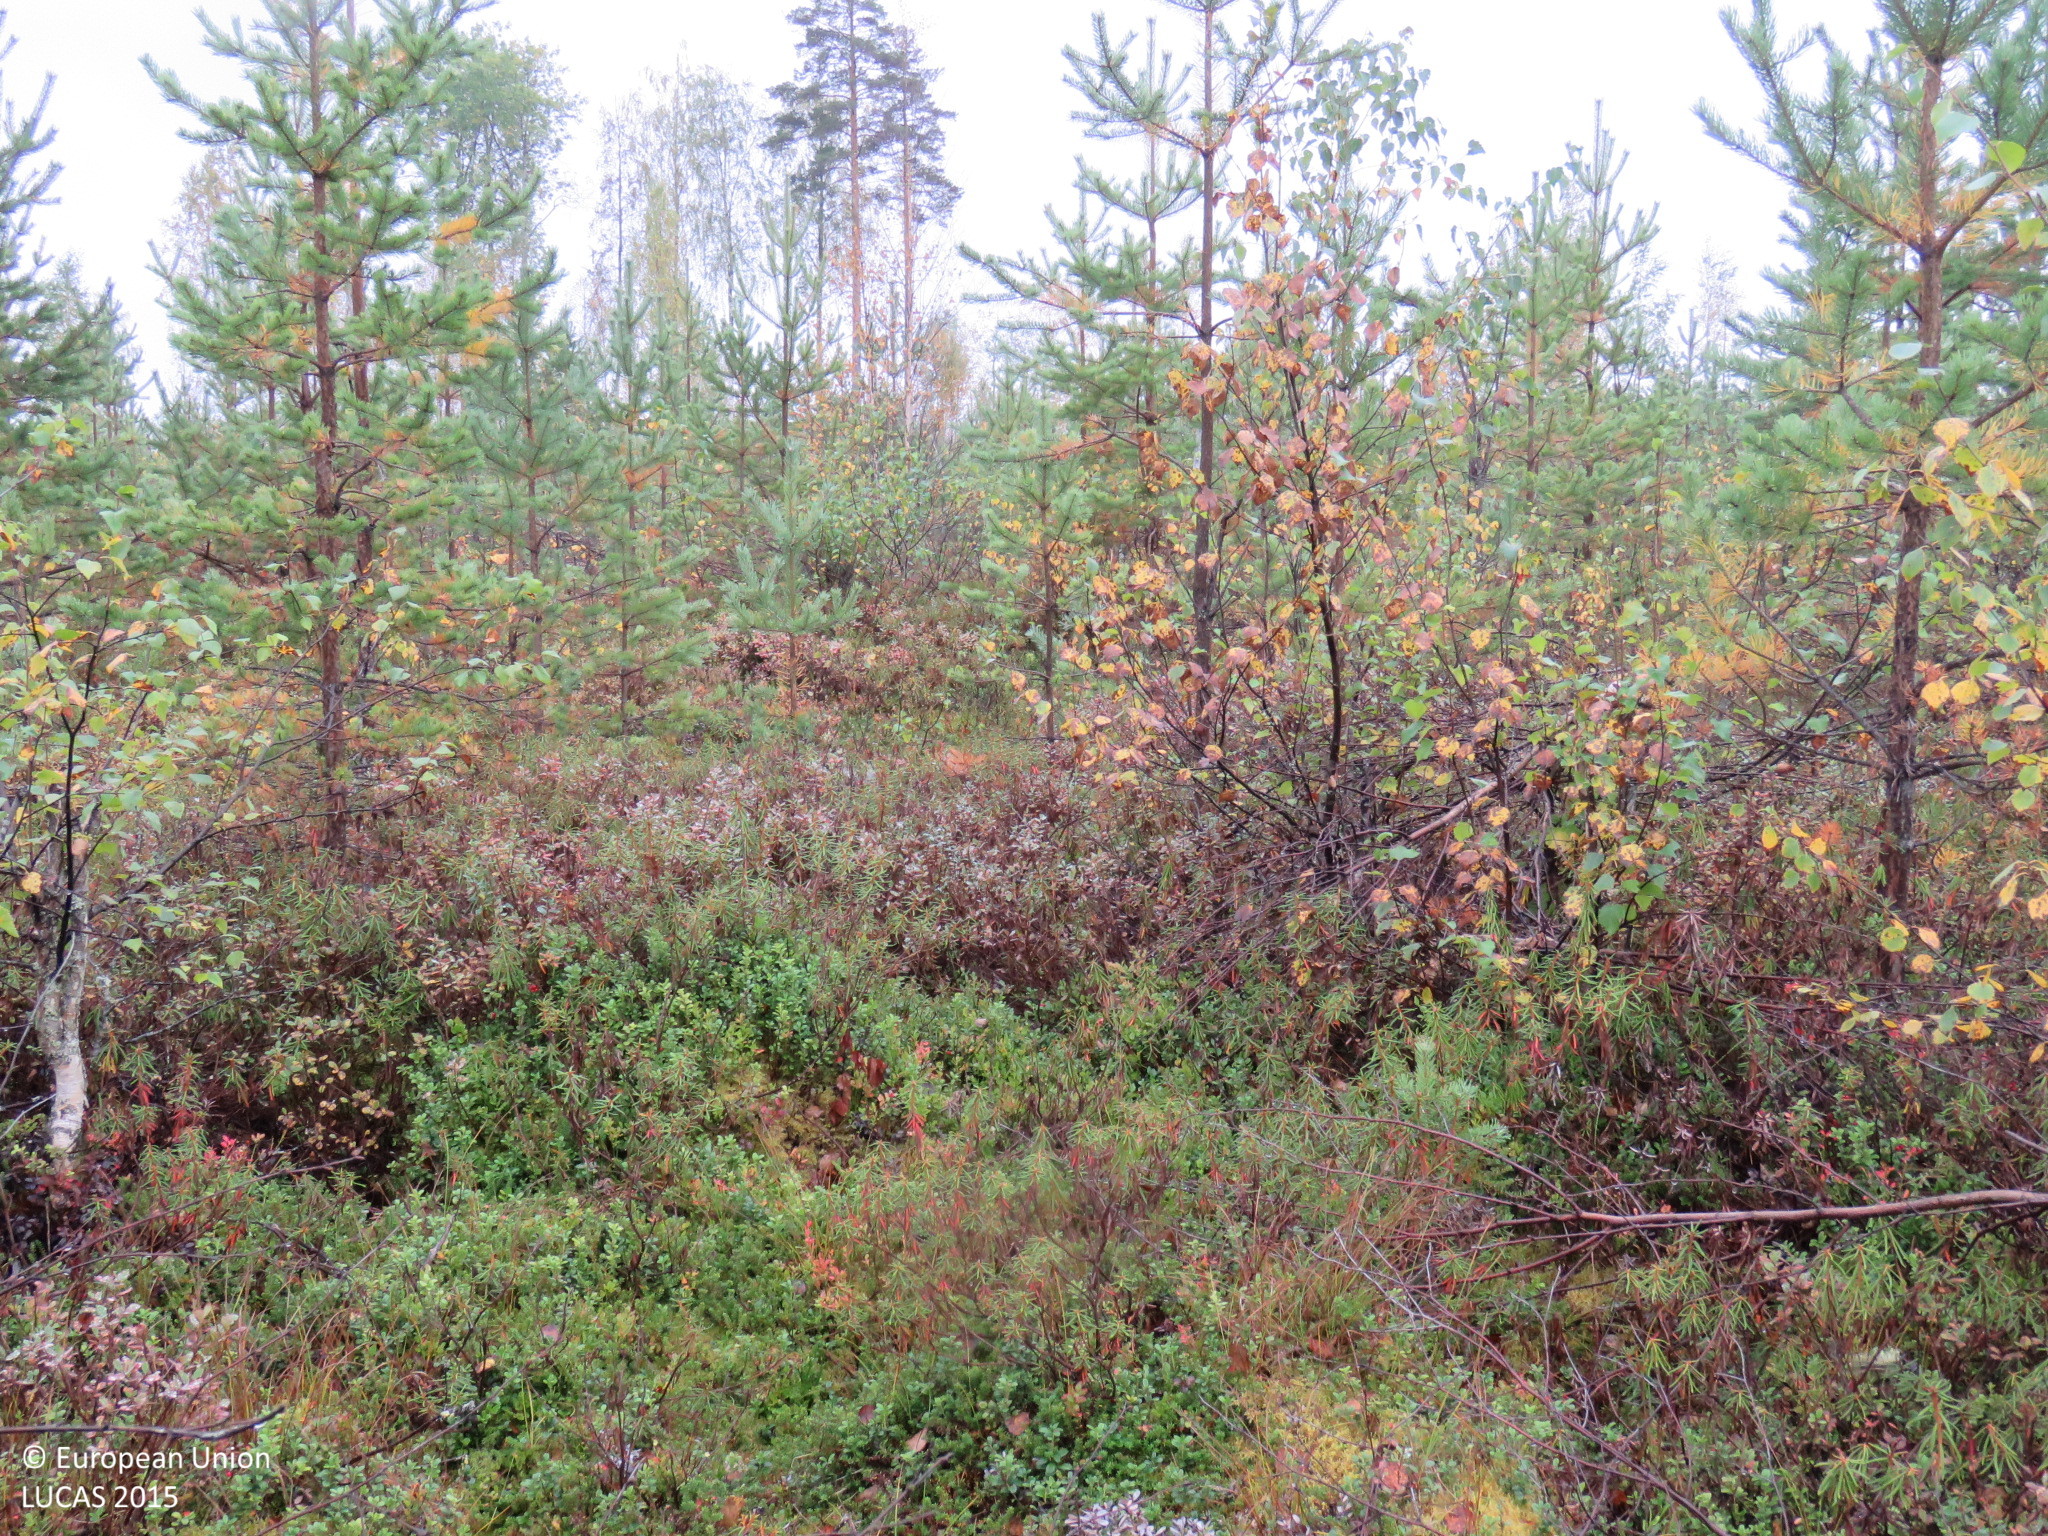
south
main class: Woodland
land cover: Pine dominated mixed woodland
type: boreal forest
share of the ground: 50 - 75 %
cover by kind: coniferous forest trees 30 %, shrubs 30 %, broadleaved forest trees 20 %, lichens and mosses 15 %, herbaceous plants 5 %
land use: Forestry
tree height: < 5 m
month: September
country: FI
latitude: 64.8346
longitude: 26.5729
